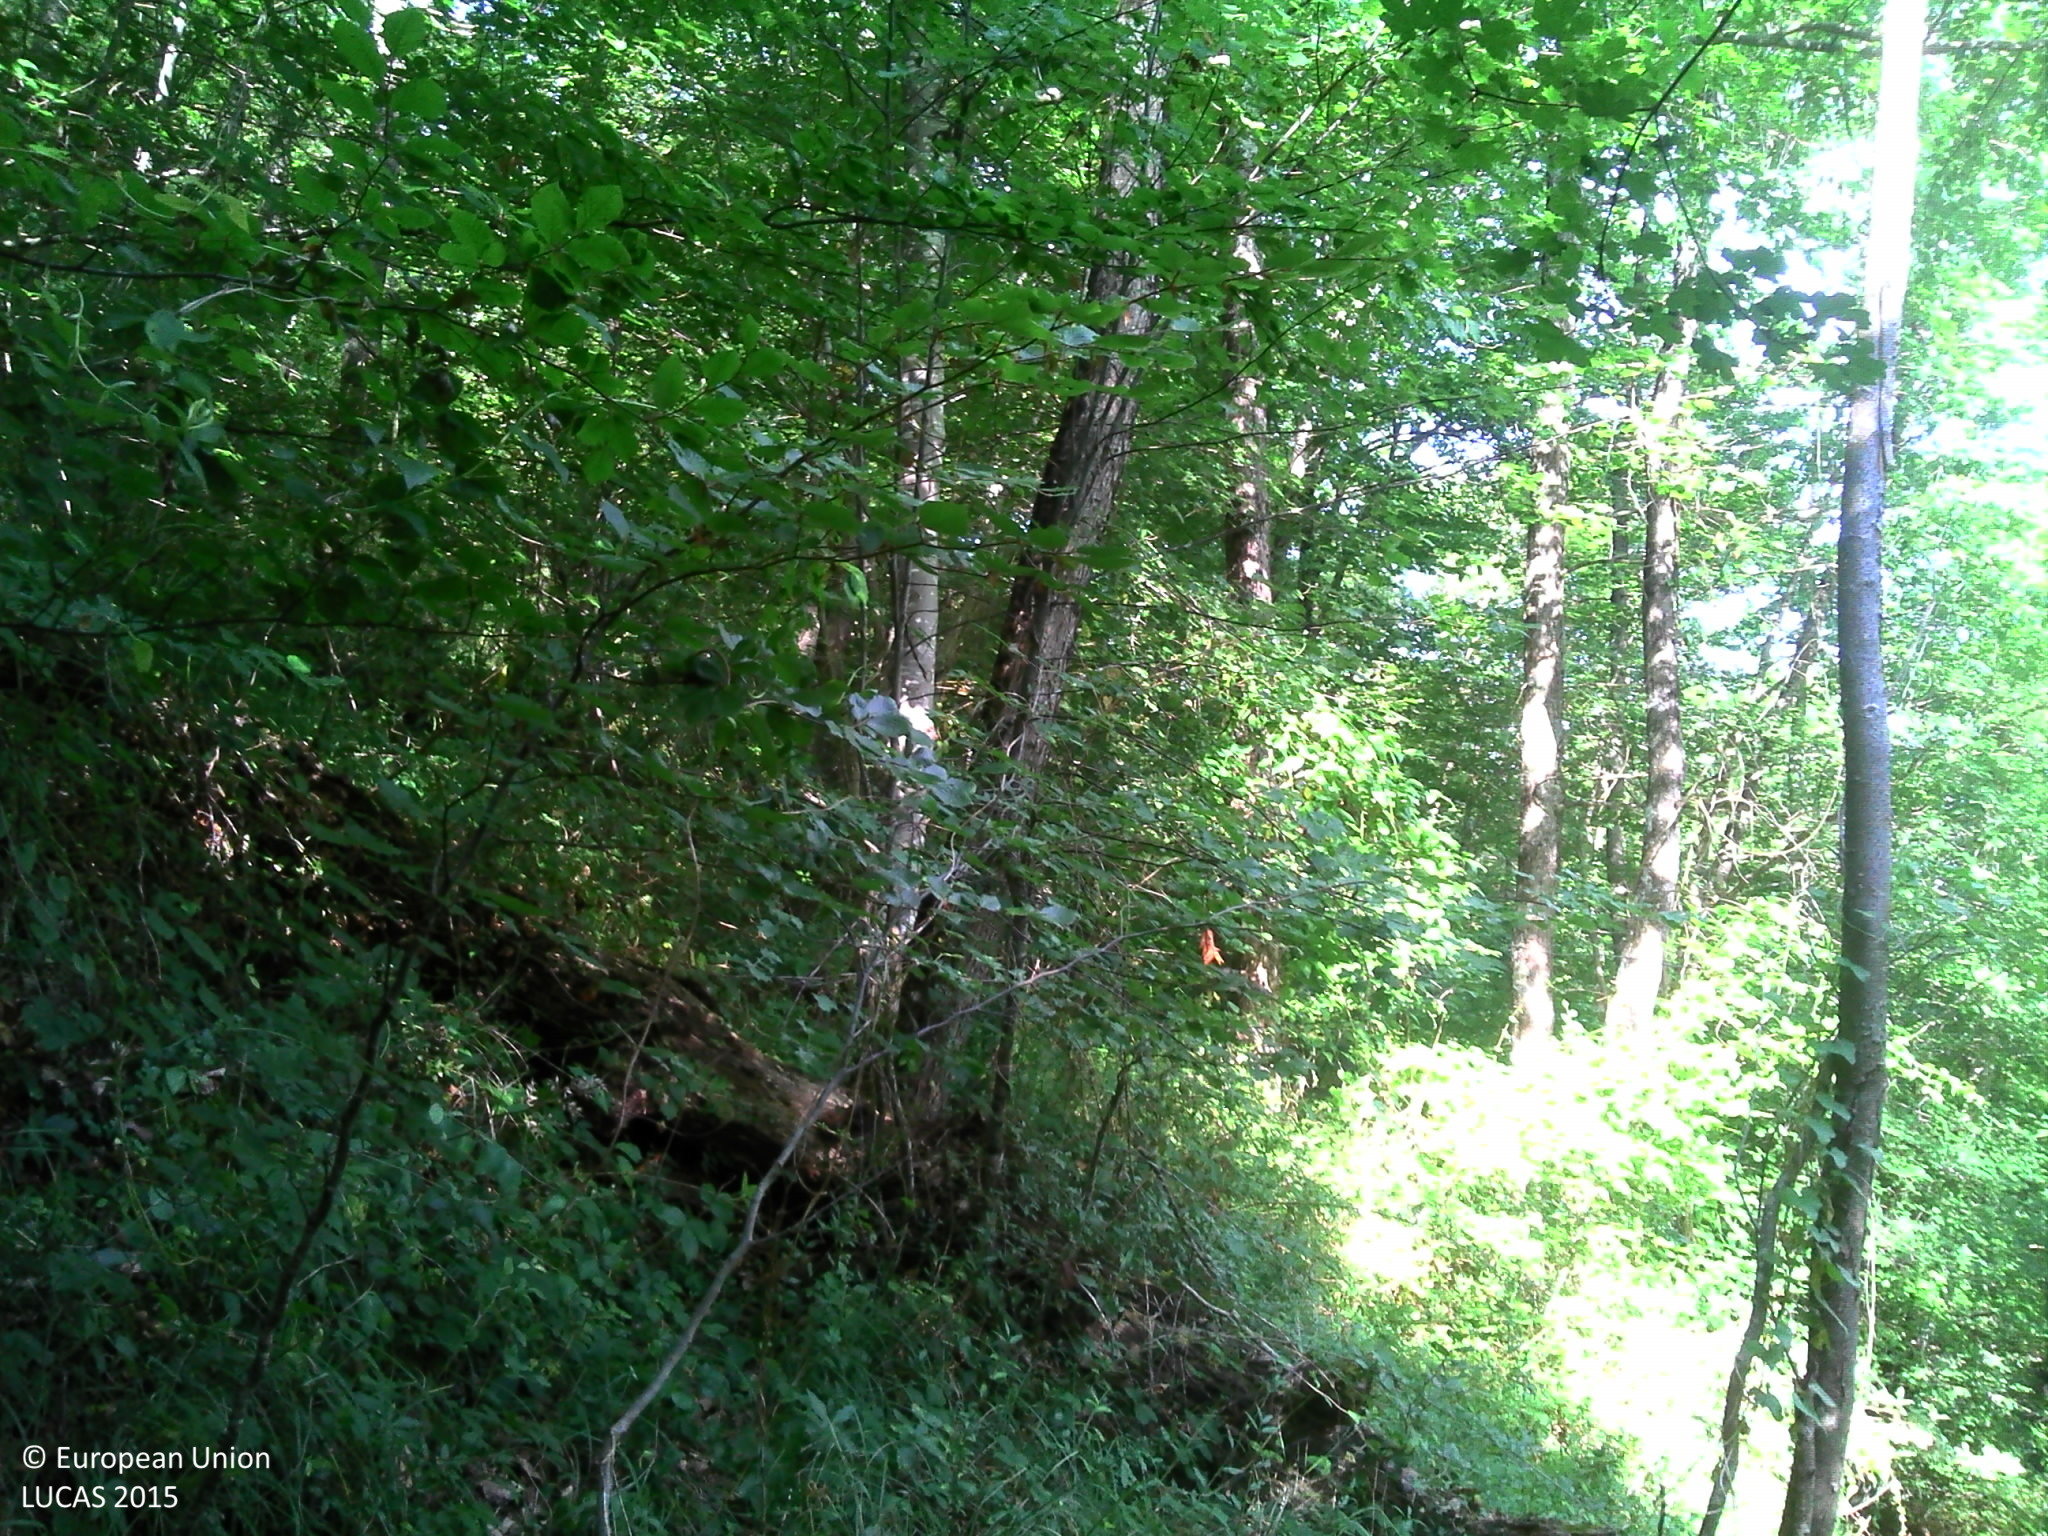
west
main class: Woodland
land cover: Broadleaved woodland
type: acidophilous oak and oak-birch forest
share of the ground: > 75 %
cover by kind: broadleaved forest trees 100 %
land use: Forestry
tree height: > 5 m
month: July
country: FR
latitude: 43.1615
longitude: 1.0125
